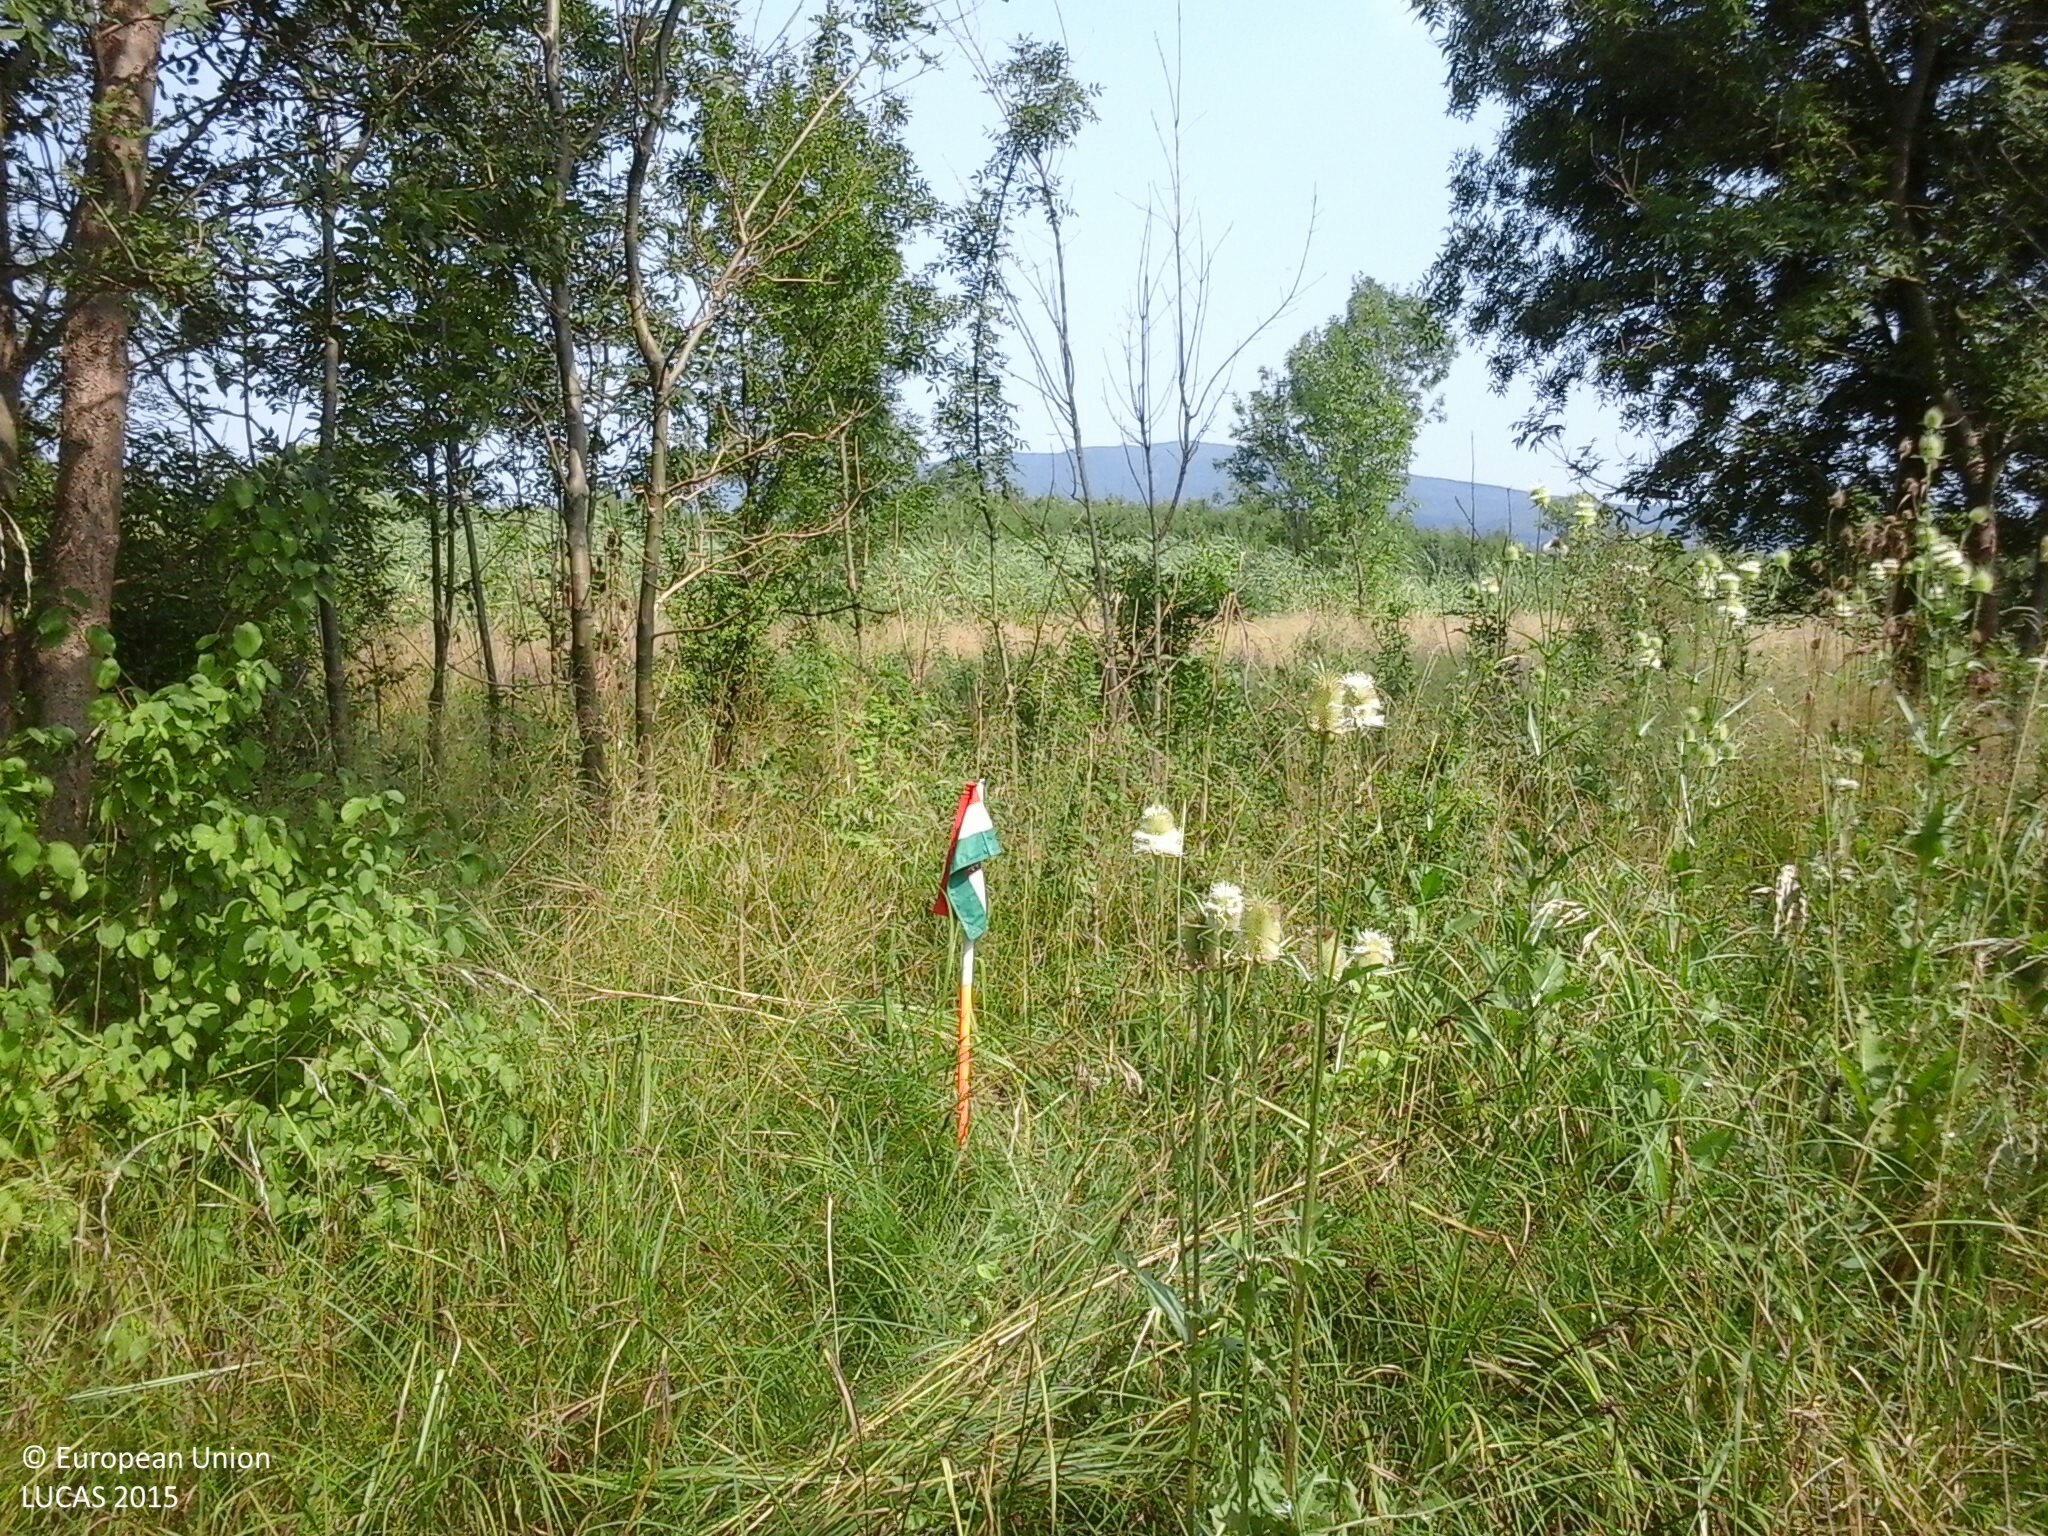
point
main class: Woodland
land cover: Broadleaved woodland
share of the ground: 25 - 50 %
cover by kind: herbaceous plants 60 %, broadleaved forest trees 40 %
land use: Abandoned areas
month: August
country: HU
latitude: 46.0391
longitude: 18.1601
